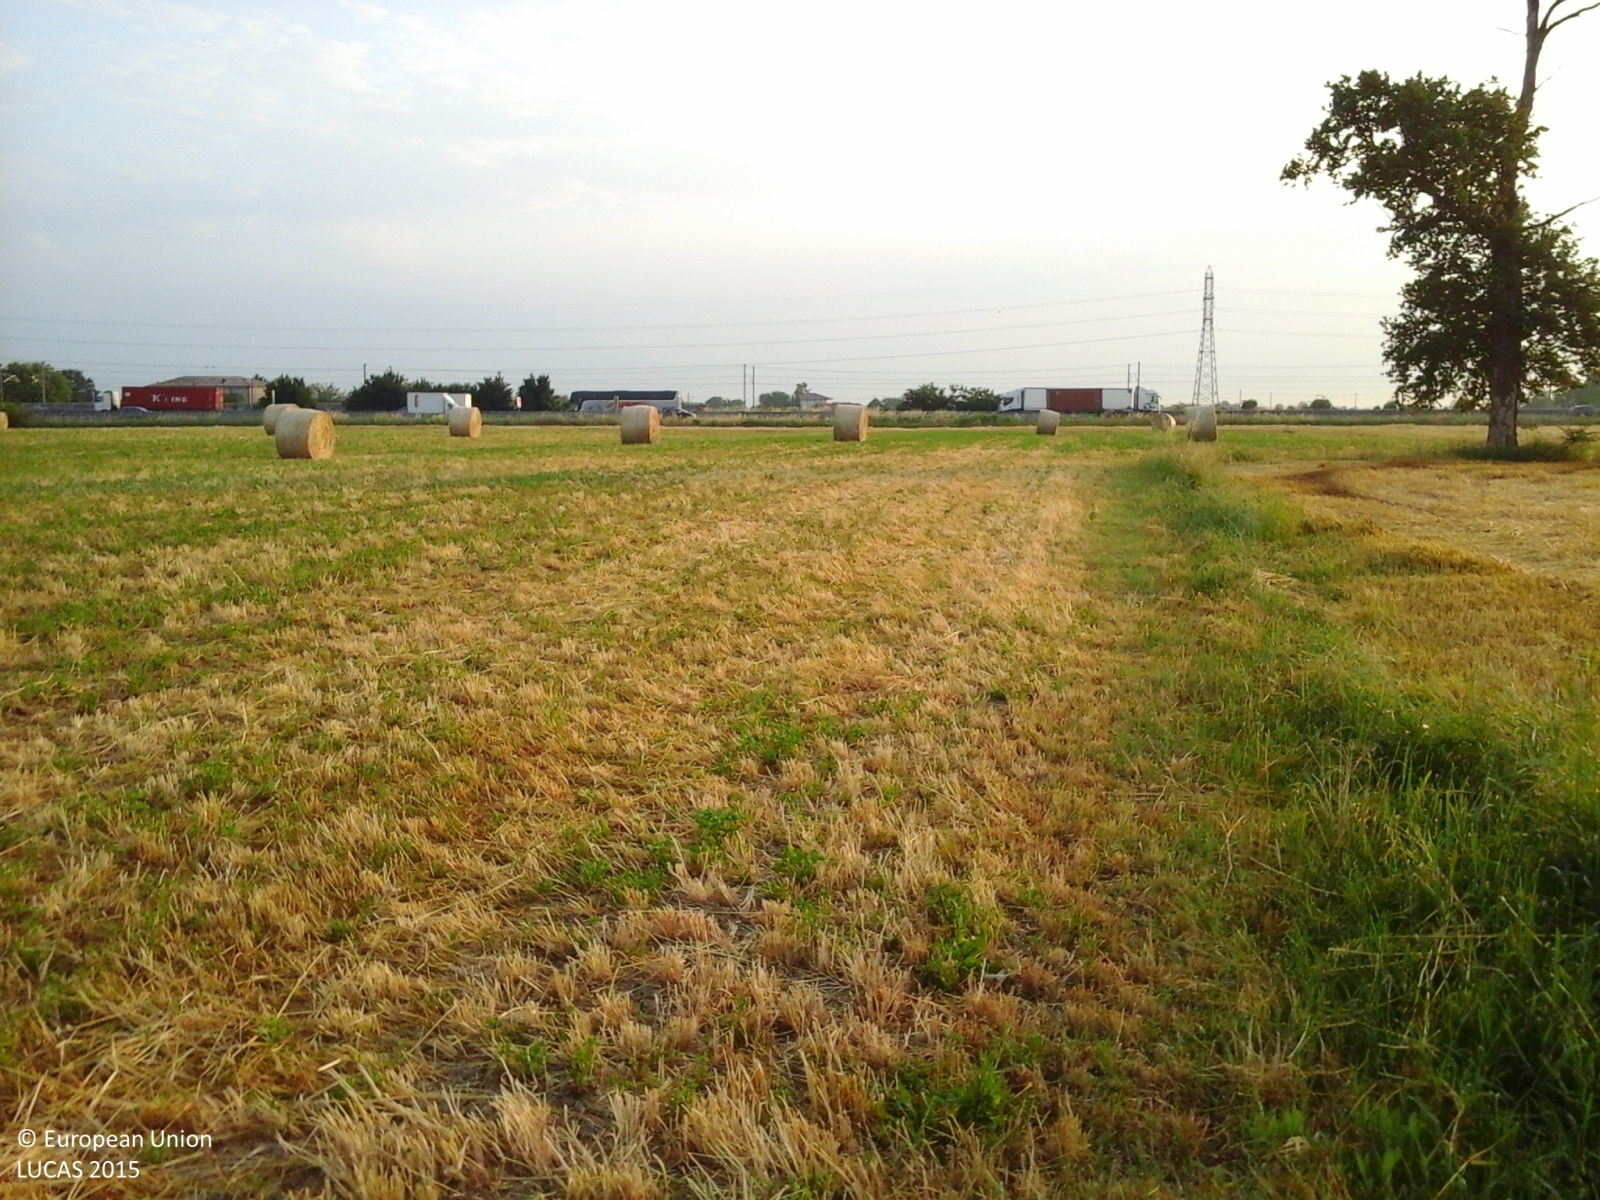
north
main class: Grassland
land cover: Spontaneously vegetated surfaces
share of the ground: 10 - 25 %
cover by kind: unconsolidated bare surface 90 %, herbaceous plants 10 %
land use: Agriculture (excluding fallow land and kitchen gardens)
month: June
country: IT
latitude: 44.8915
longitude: 10.0632
